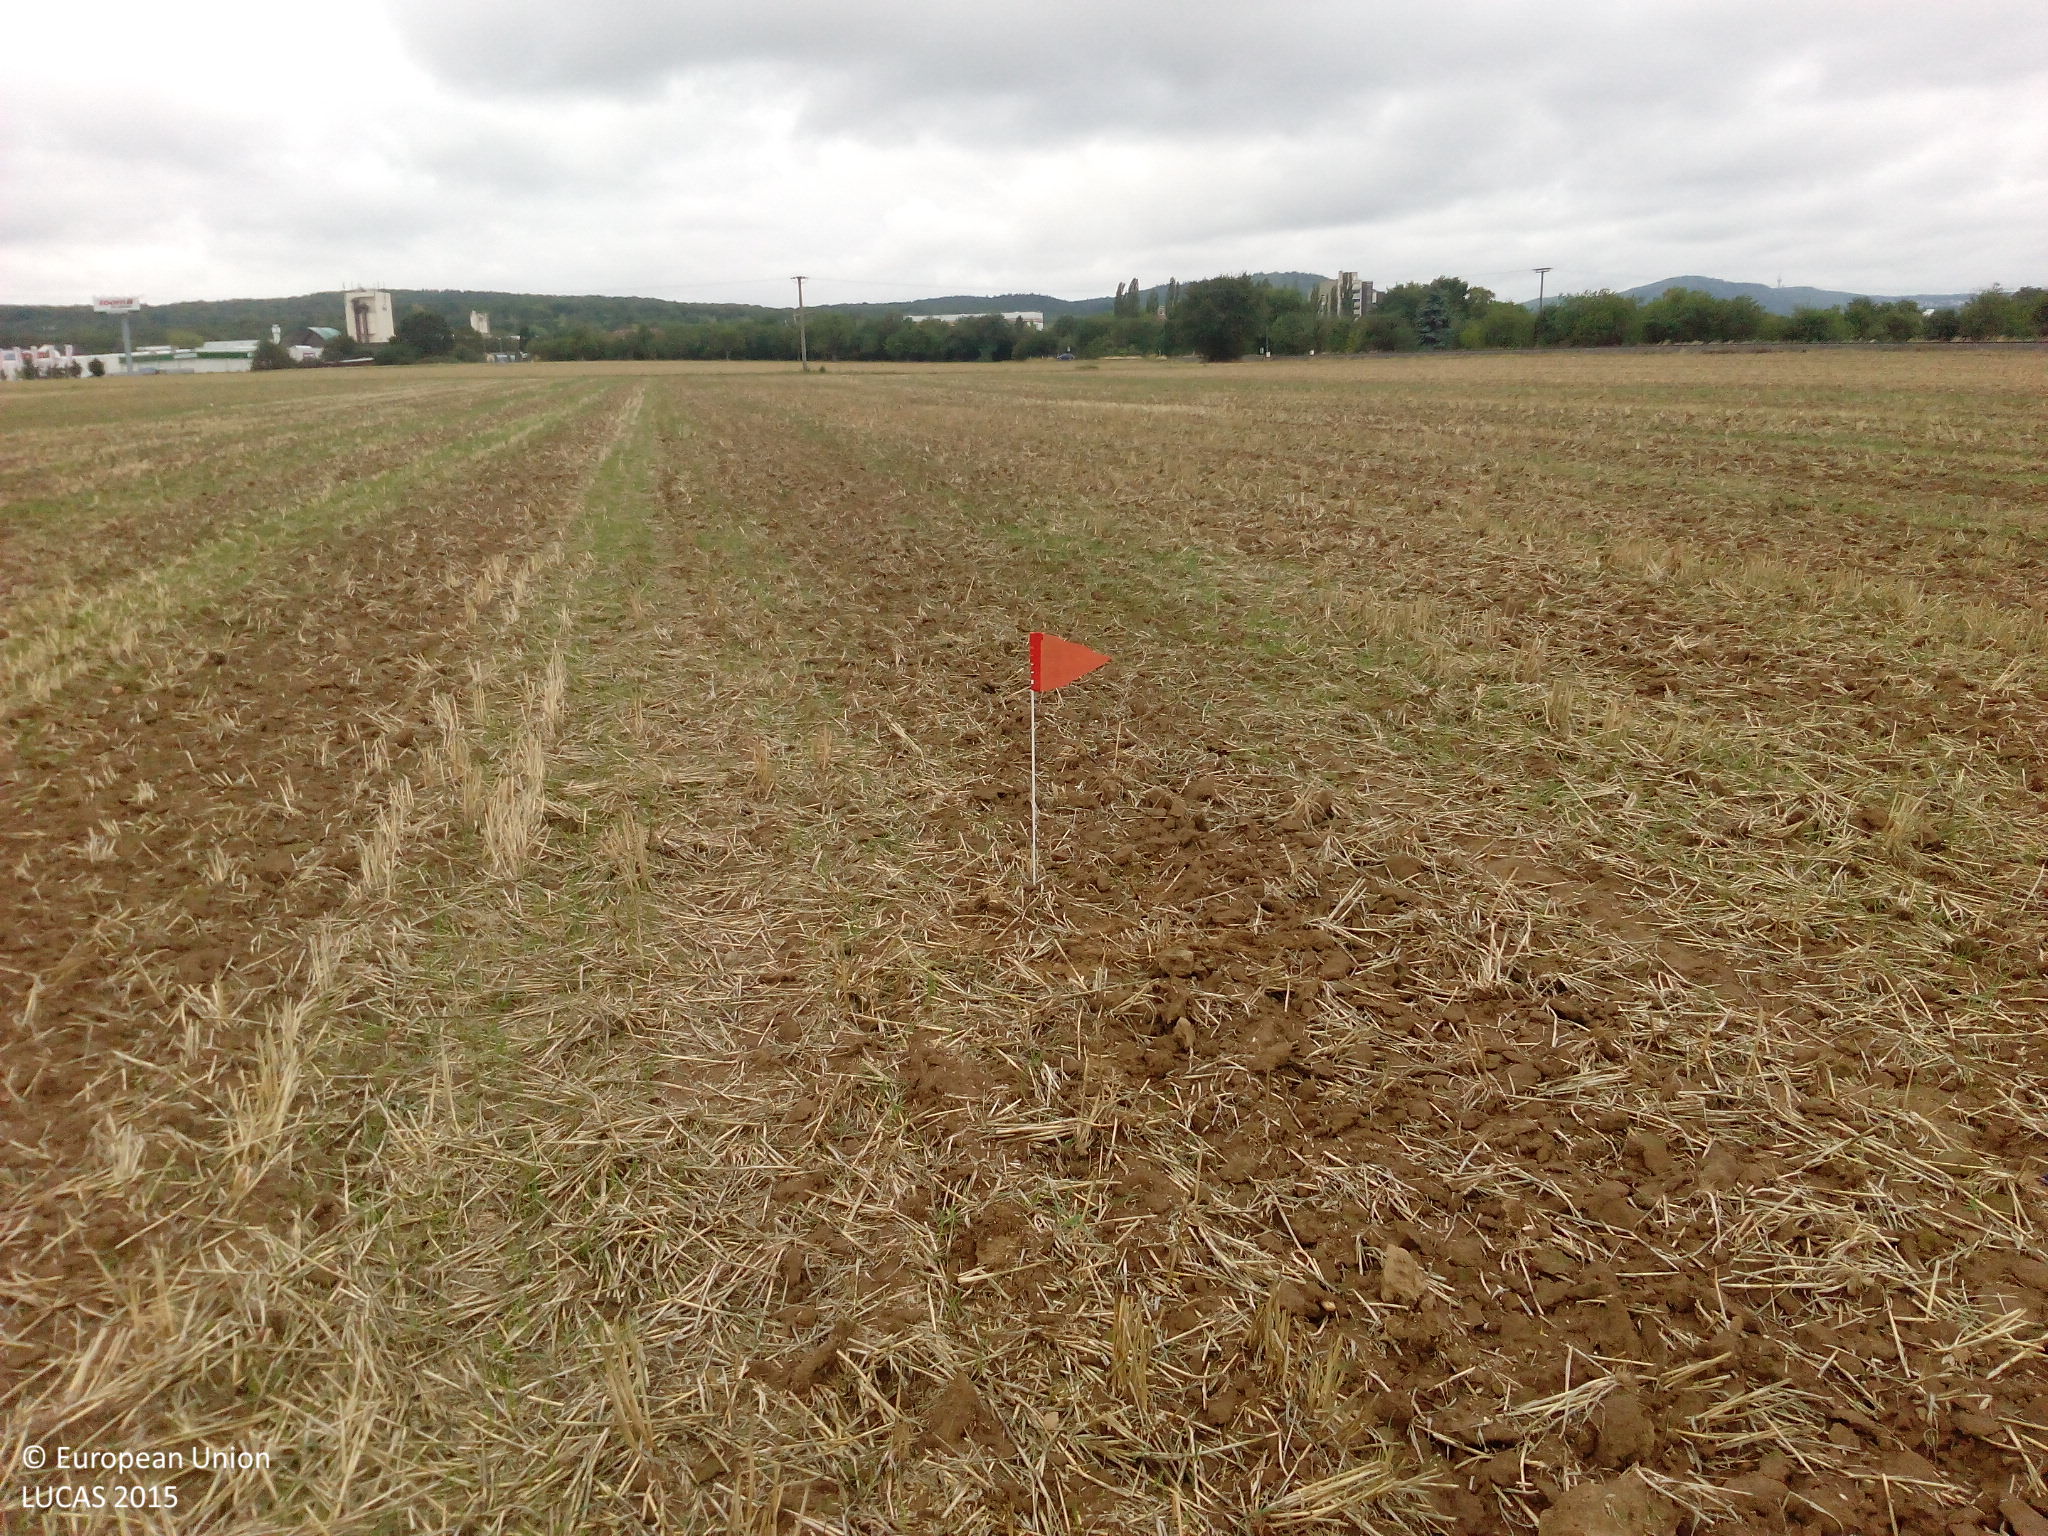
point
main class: Cropland
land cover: Common wheat
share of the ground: < 10 %
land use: Agriculture (excluding fallow land and kitchen gardens)
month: August
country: DE
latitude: 50.1201
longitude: 8.4759
